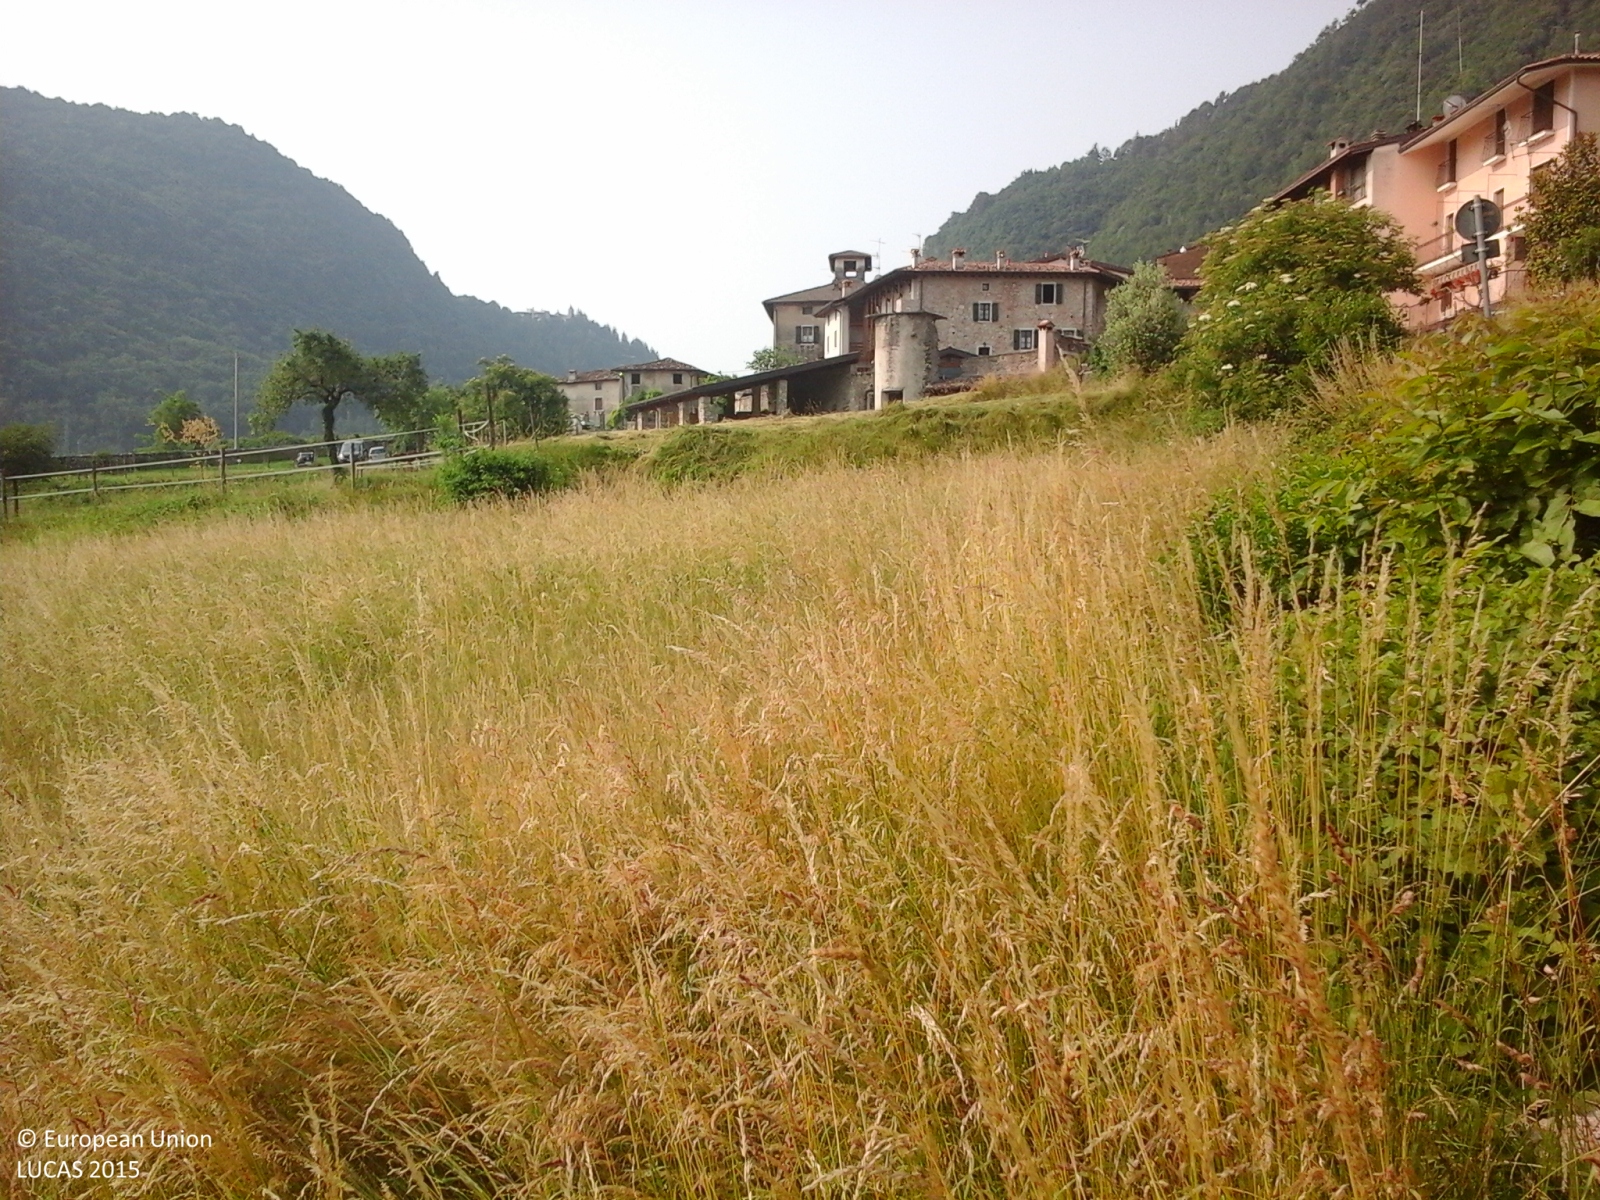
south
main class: Grassland
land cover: Grassland without tree/shrub cover
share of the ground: > 75 %
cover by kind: herbaceous plants 100 %
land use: Agriculture (excluding fallow land and kitchen gardens)
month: June
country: IT
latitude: 45.7542
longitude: 10.7316
